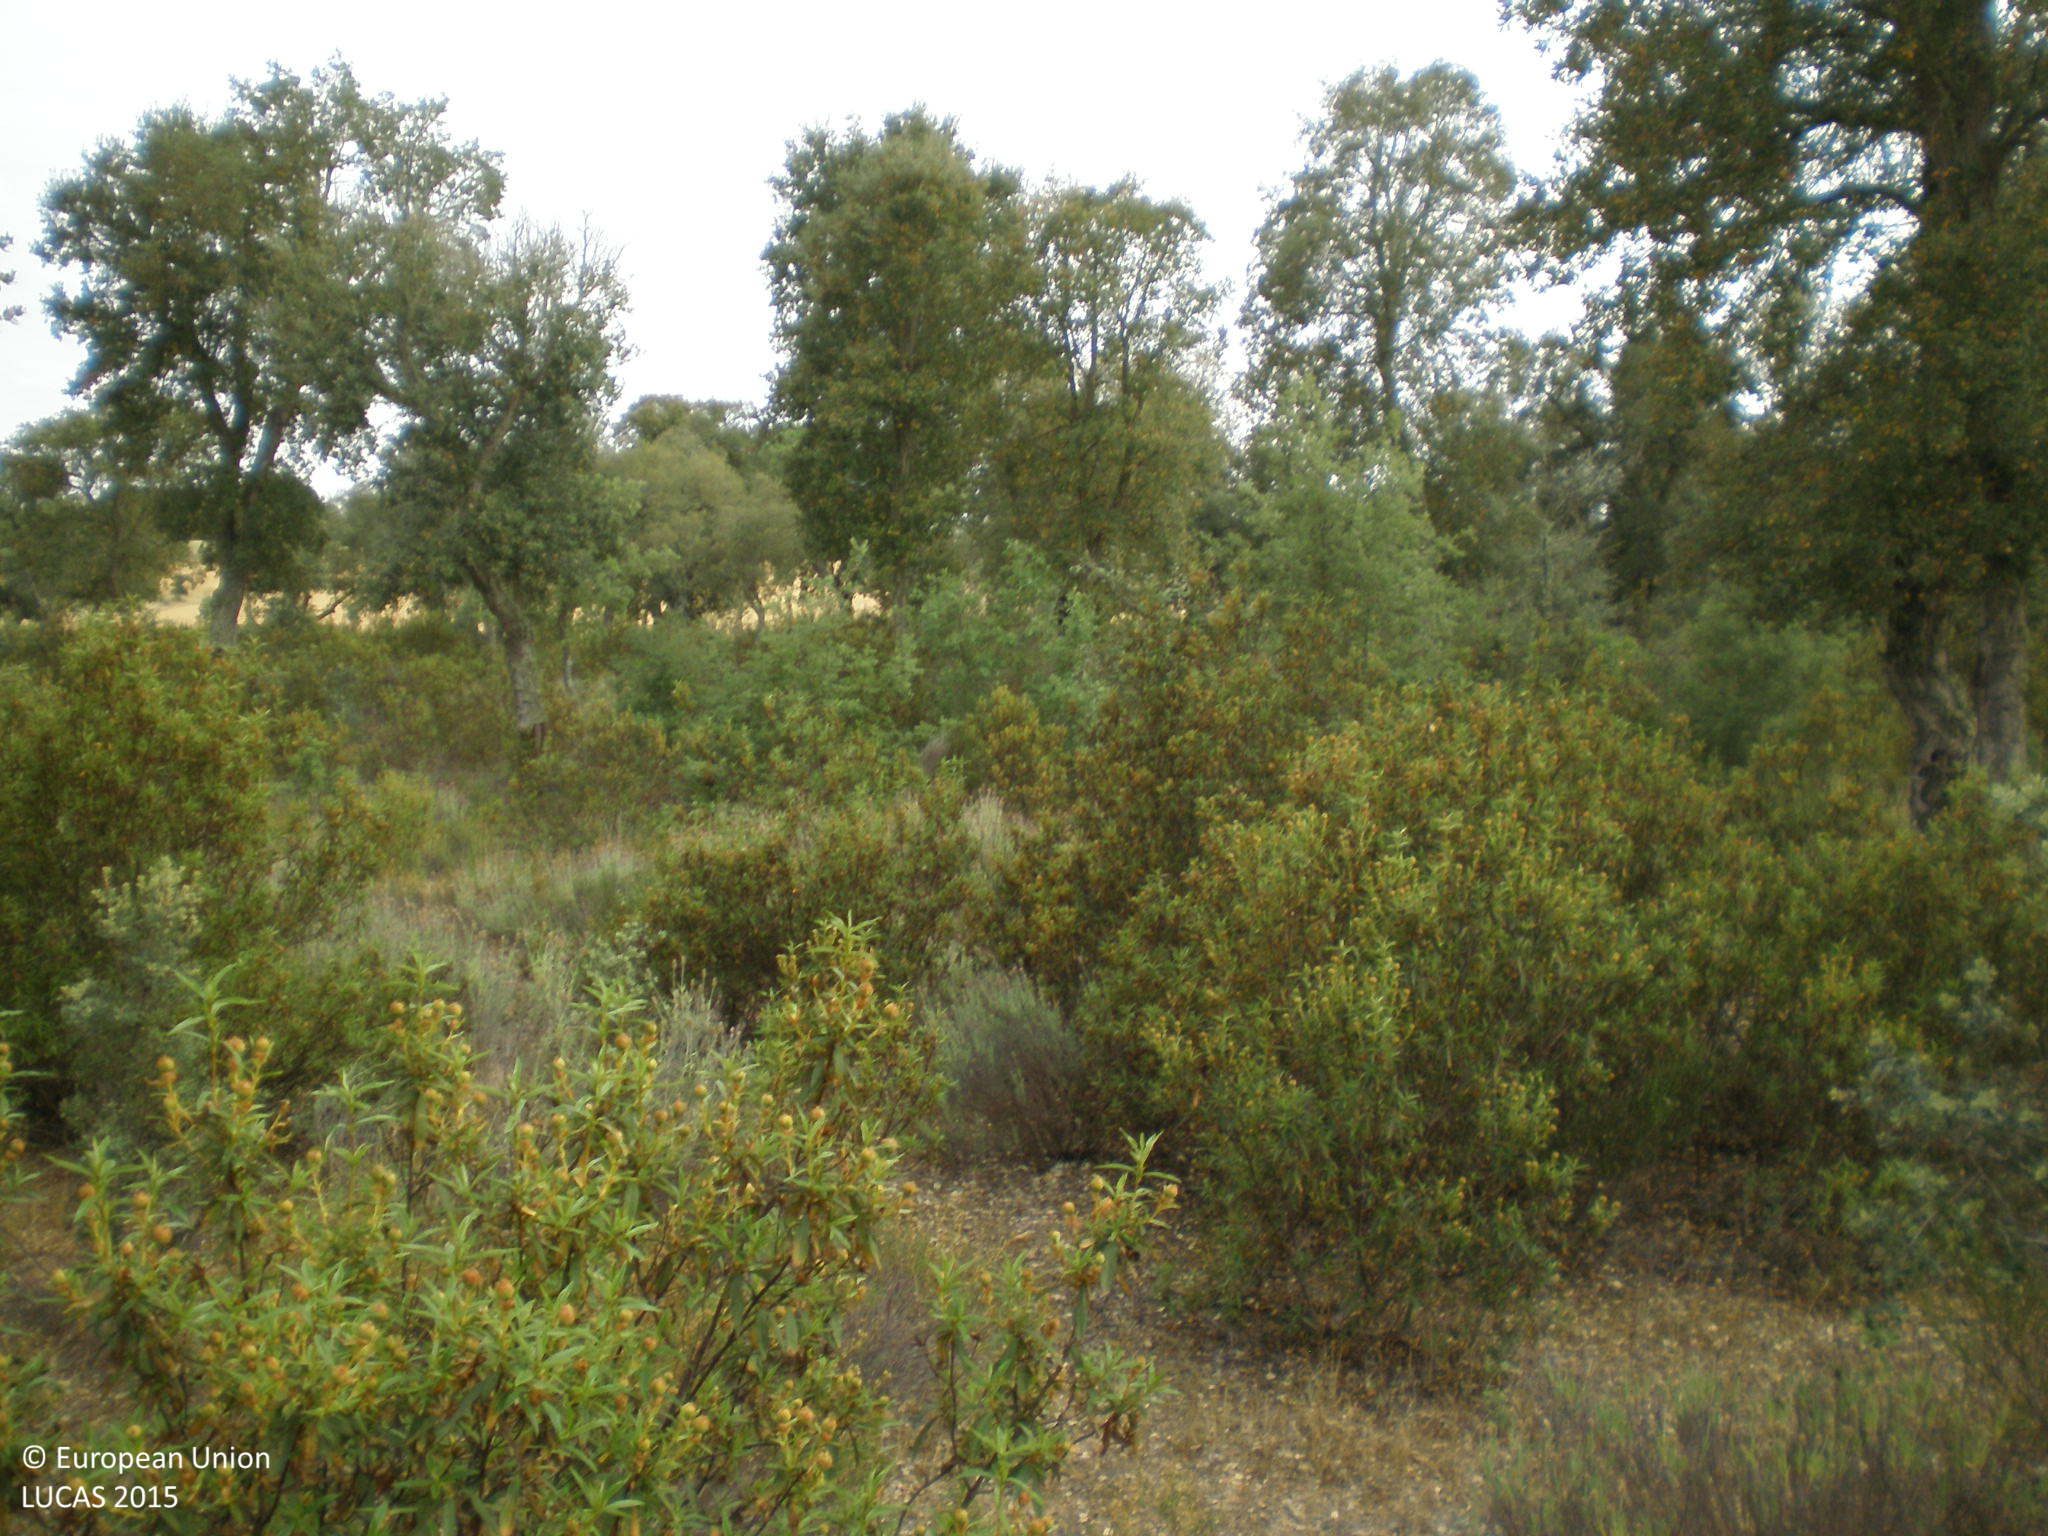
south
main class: Woodland
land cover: Broadleaved woodland
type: broadleaved evergreen forest
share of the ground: 25 - 50 %
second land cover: Grassland without tree/shrub cover
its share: 50 - 75 %
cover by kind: herbaceous plants 60 %, broadleaved forest trees 40 %
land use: Forestry
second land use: Agriculture (excluding fallow land and kitchen gardens)
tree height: < 5 m
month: June
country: ES
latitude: 41.1515
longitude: -5.7753
